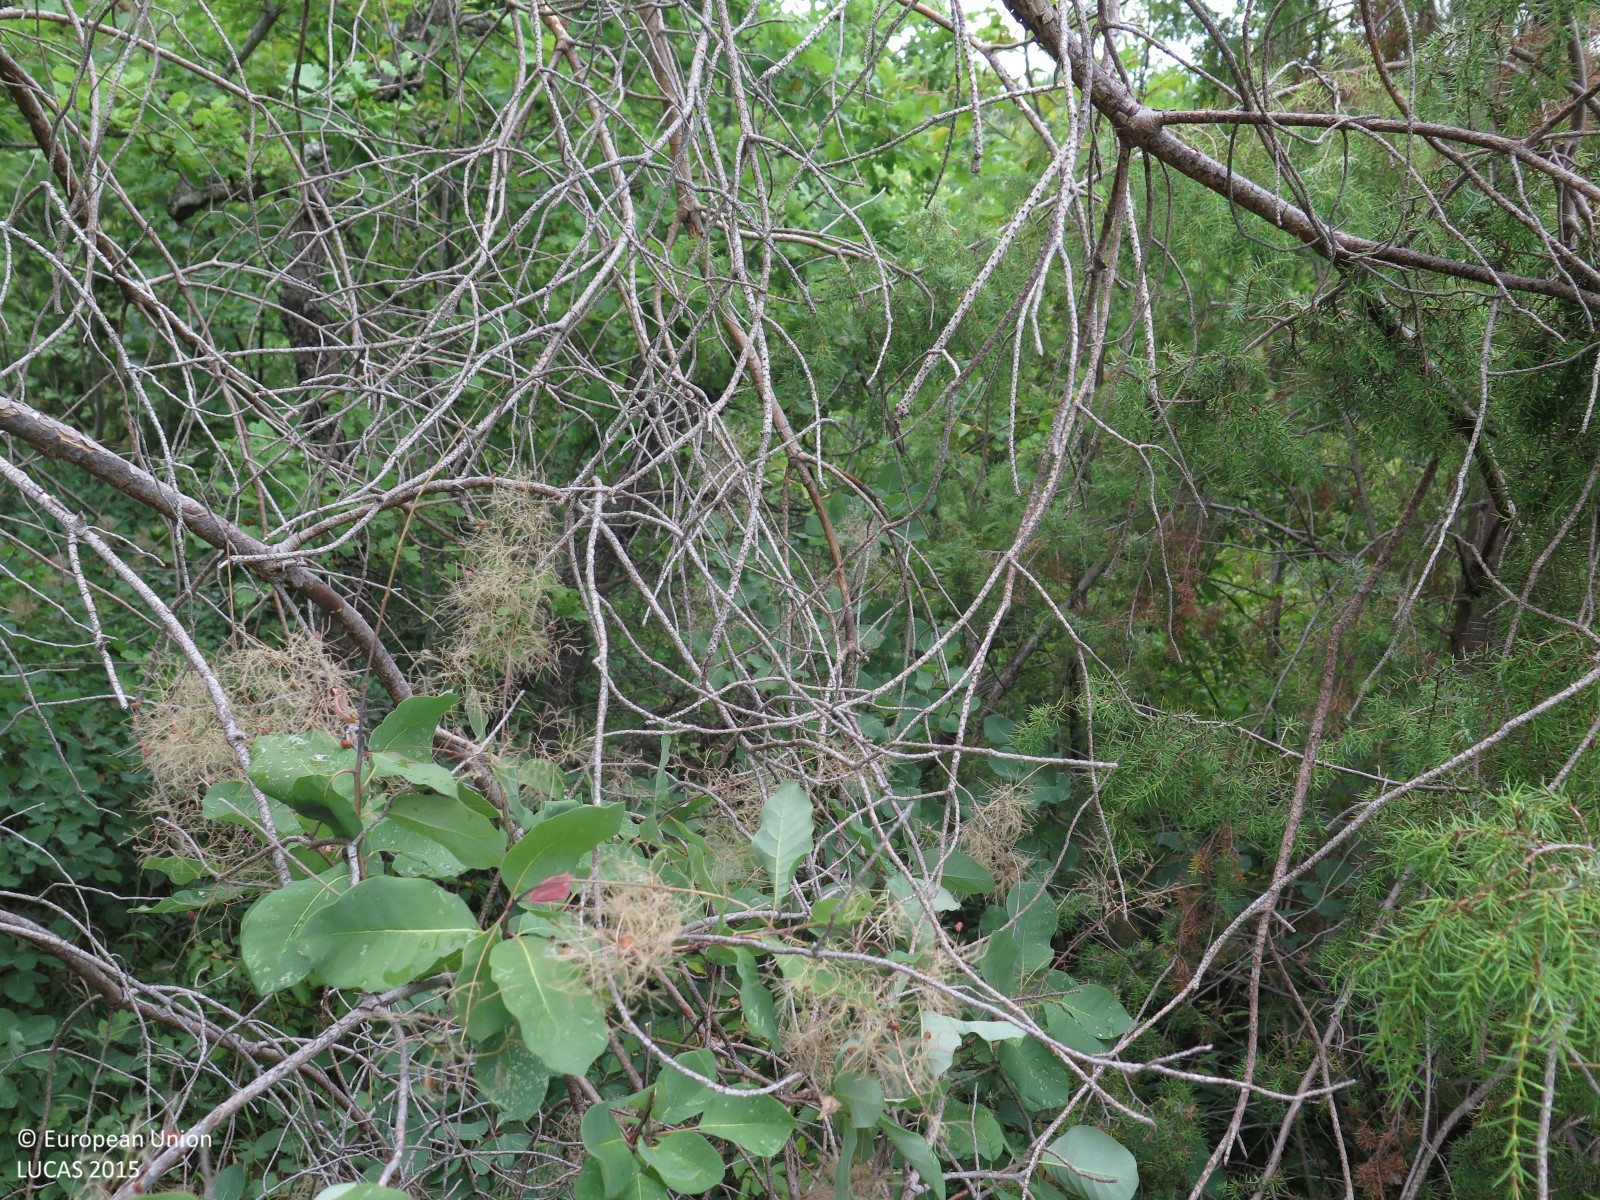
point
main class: Woodland
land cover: Other mixed woodland
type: coniferous forest of the mediterranean region
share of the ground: > 75 %
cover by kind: broadleaved forest trees 75 %, coniferous forest trees 25 %
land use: Semi-natural and natural areas not in use
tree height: < 5 m
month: July
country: HR
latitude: 45.2460
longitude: 14.0590
